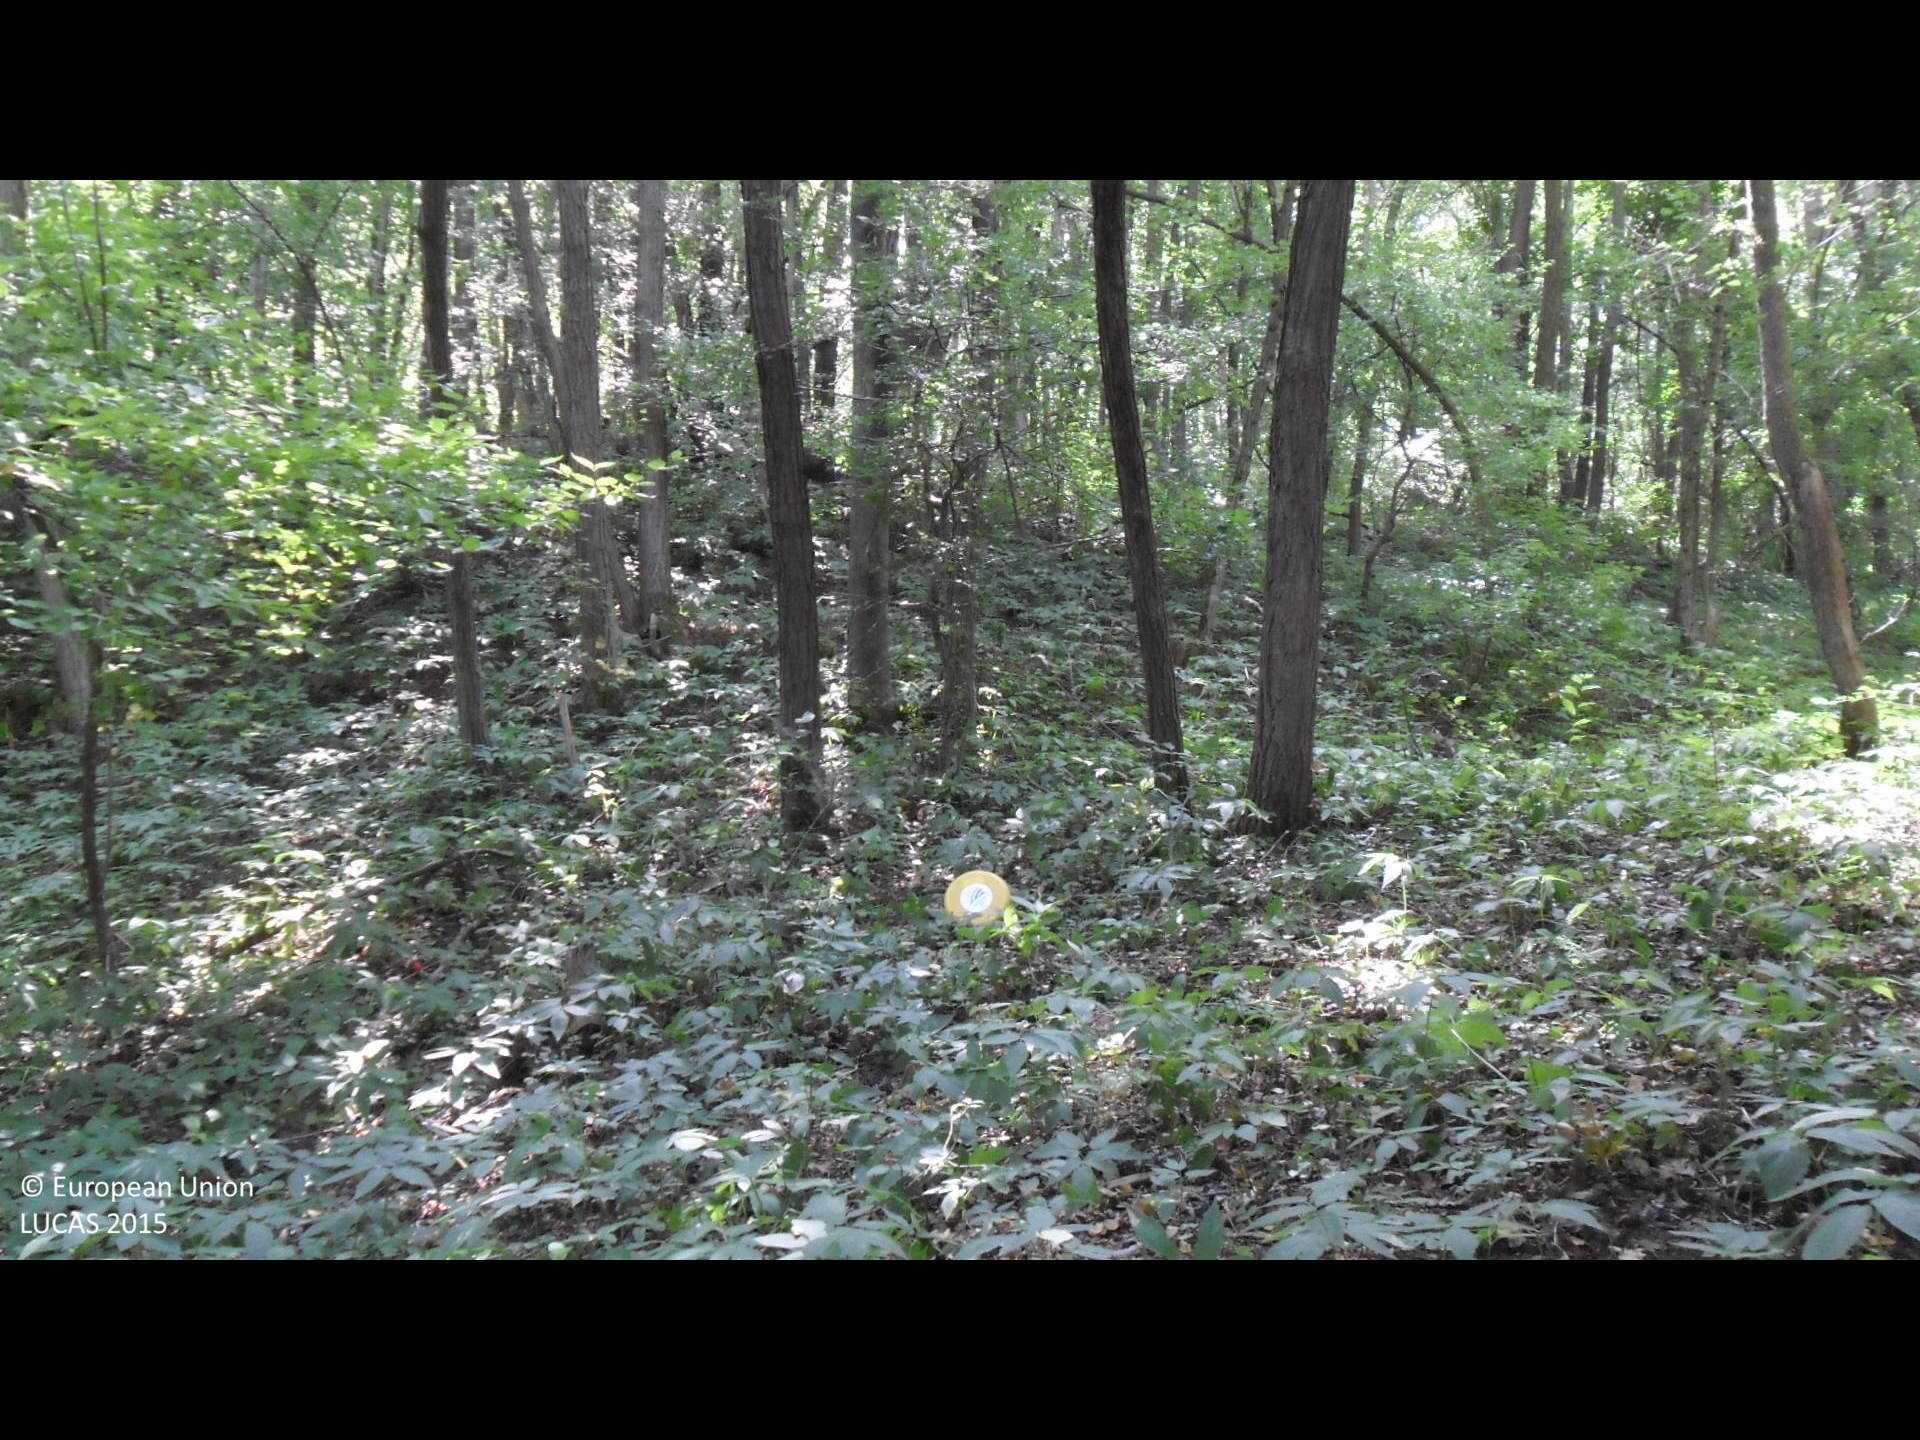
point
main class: Woodland
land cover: Broadleaved woodland
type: mesophytic deciduous forest
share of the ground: > 75 %
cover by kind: broadleaved forest trees 100 %
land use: Forestry
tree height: > 5 m
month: August
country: BG
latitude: 43.2718
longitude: 26.2994
